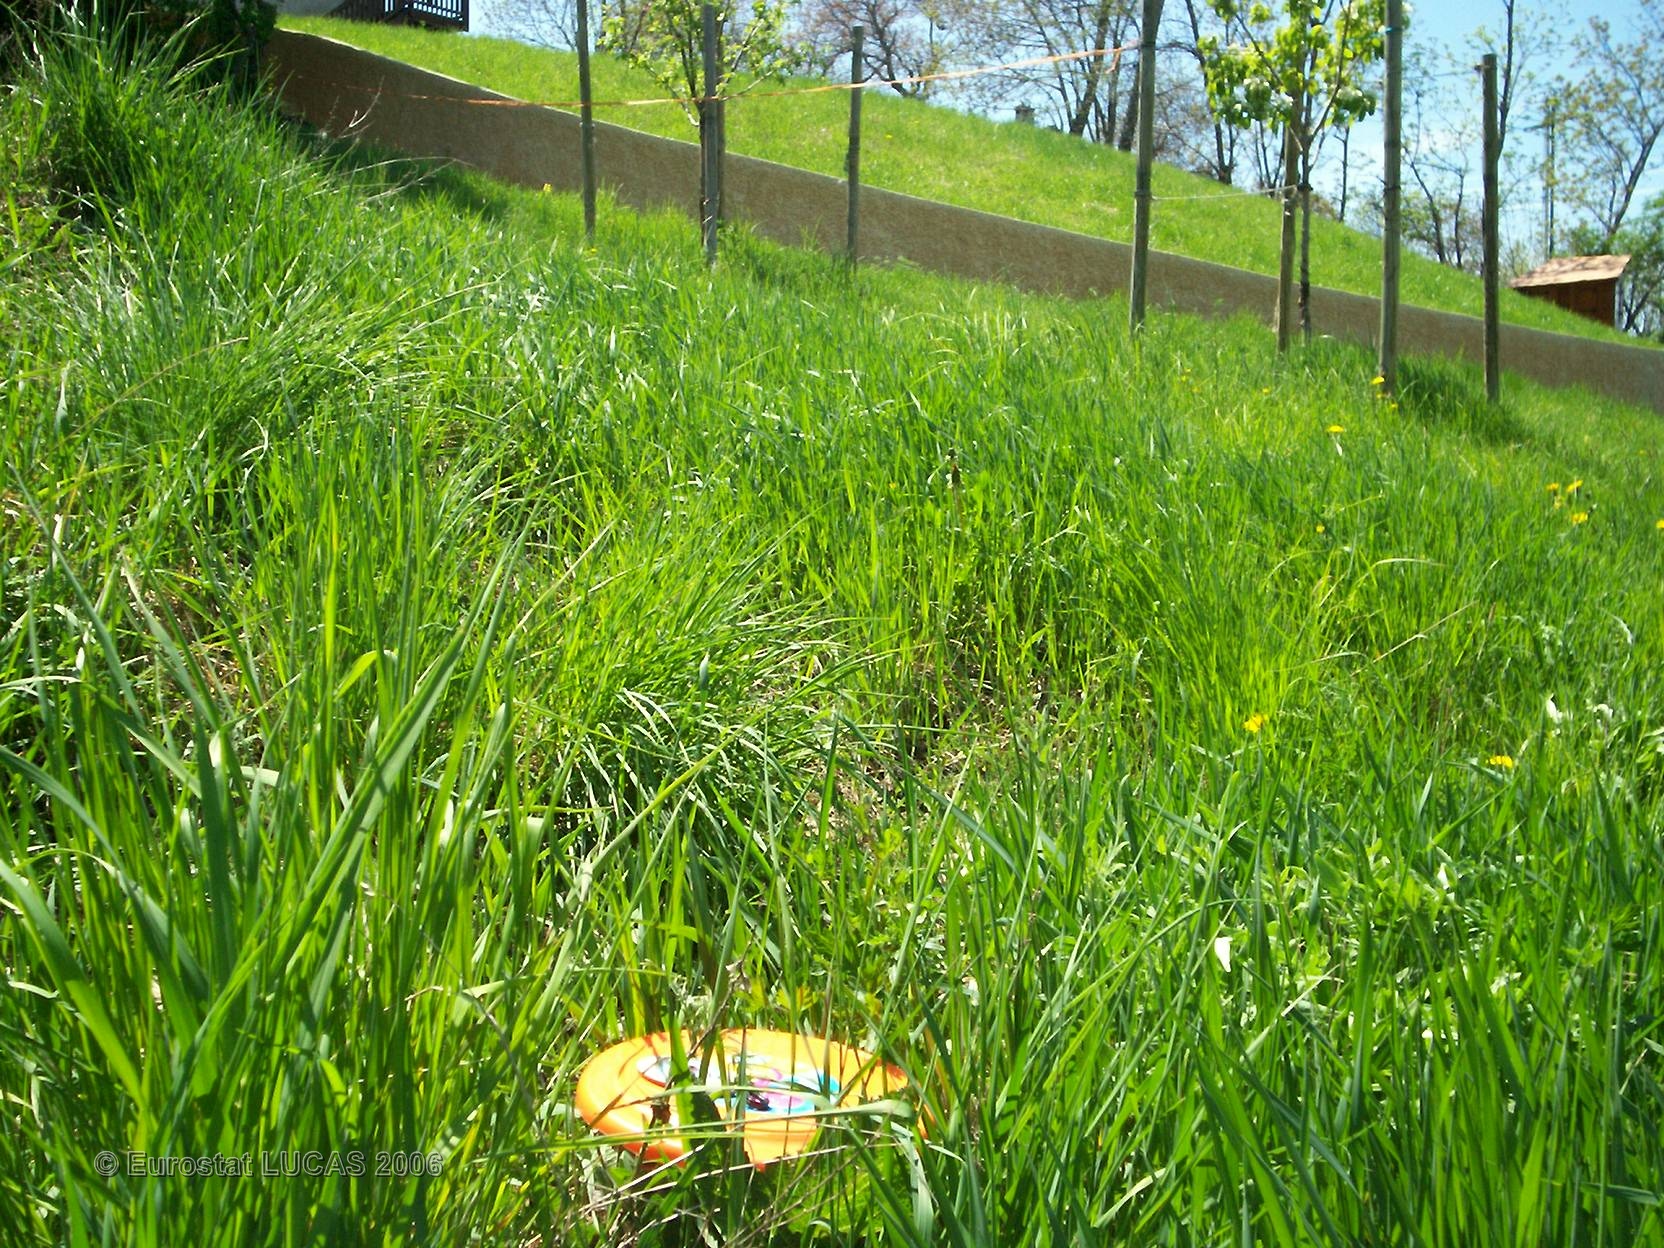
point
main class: Grassland
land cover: Grassland with sparse tree/shrub cover
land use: Agriculture (excluding fallow land and kitchen gardens)
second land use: Residential
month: May
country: FR
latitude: 44.5252
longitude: 6.4707
